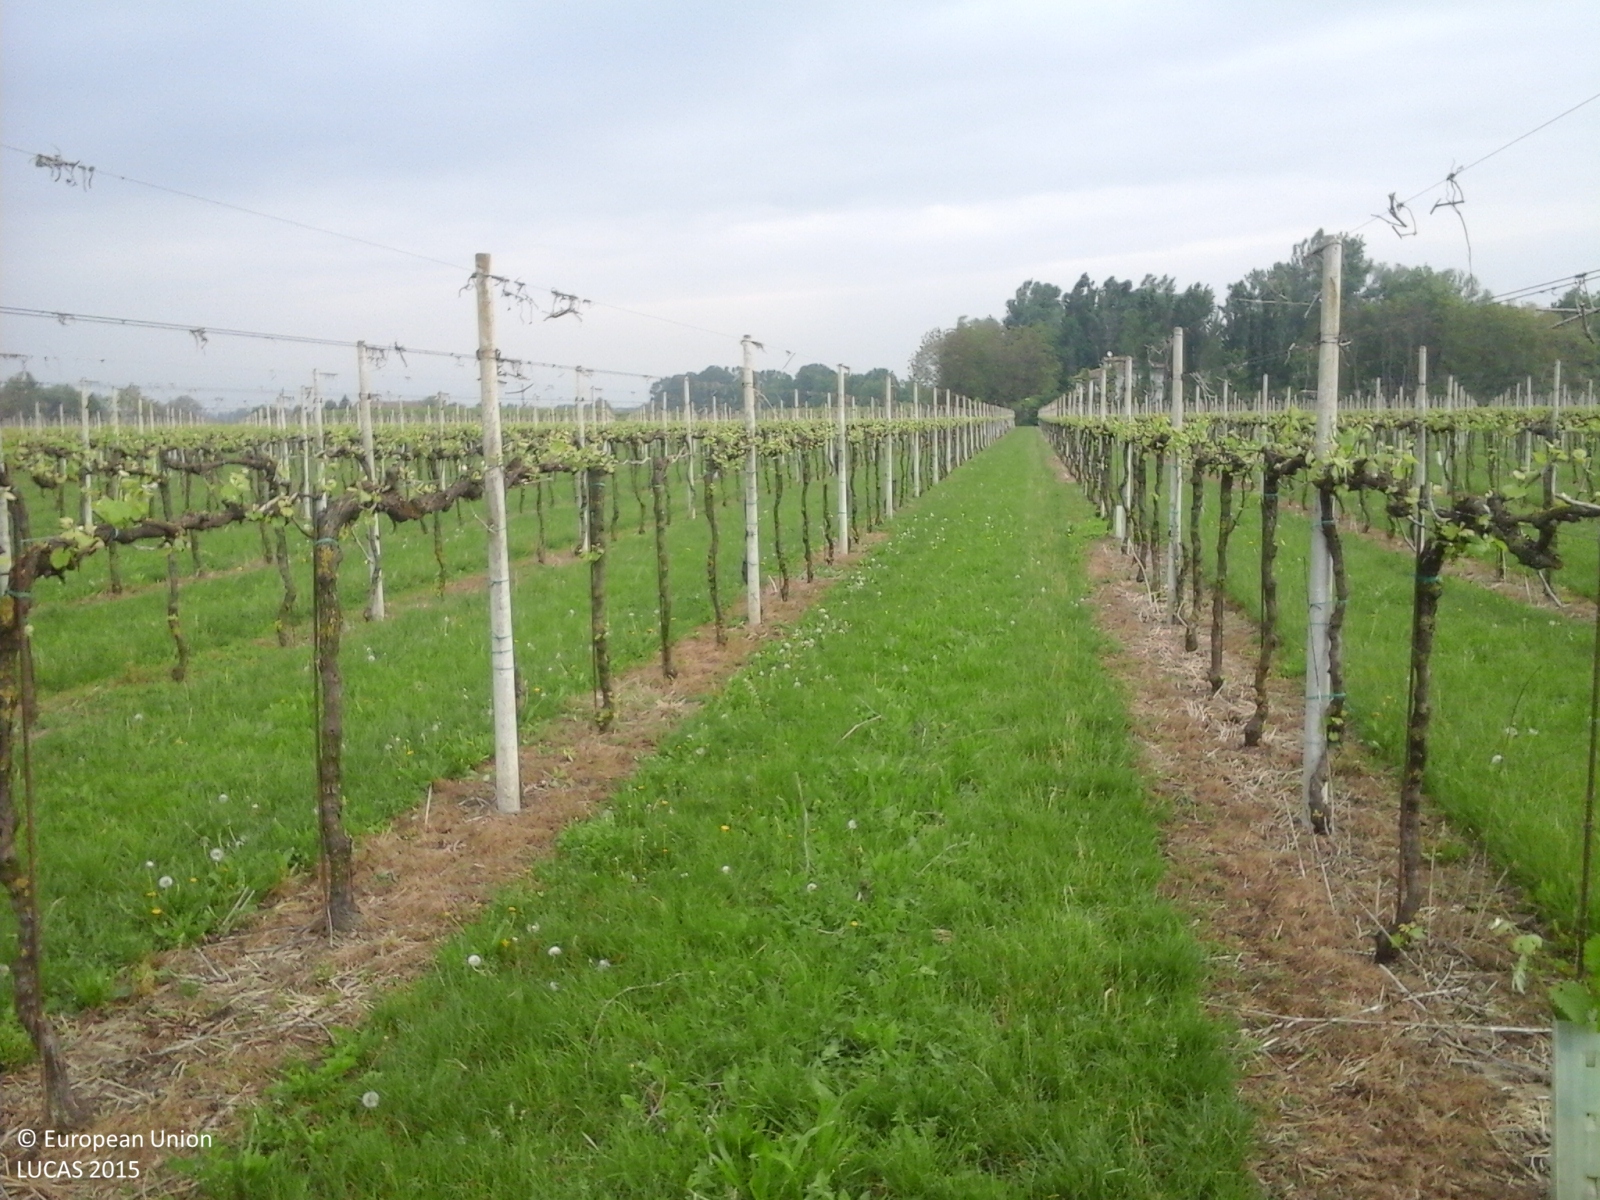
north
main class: Cropland
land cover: Vineyards
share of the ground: 10 - 25 %
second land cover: Grassland without tree/shrub cover
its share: > 75 %
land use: Agriculture (excluding fallow land and kitchen gardens)
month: April
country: IT
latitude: 44.8879
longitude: 10.8719
